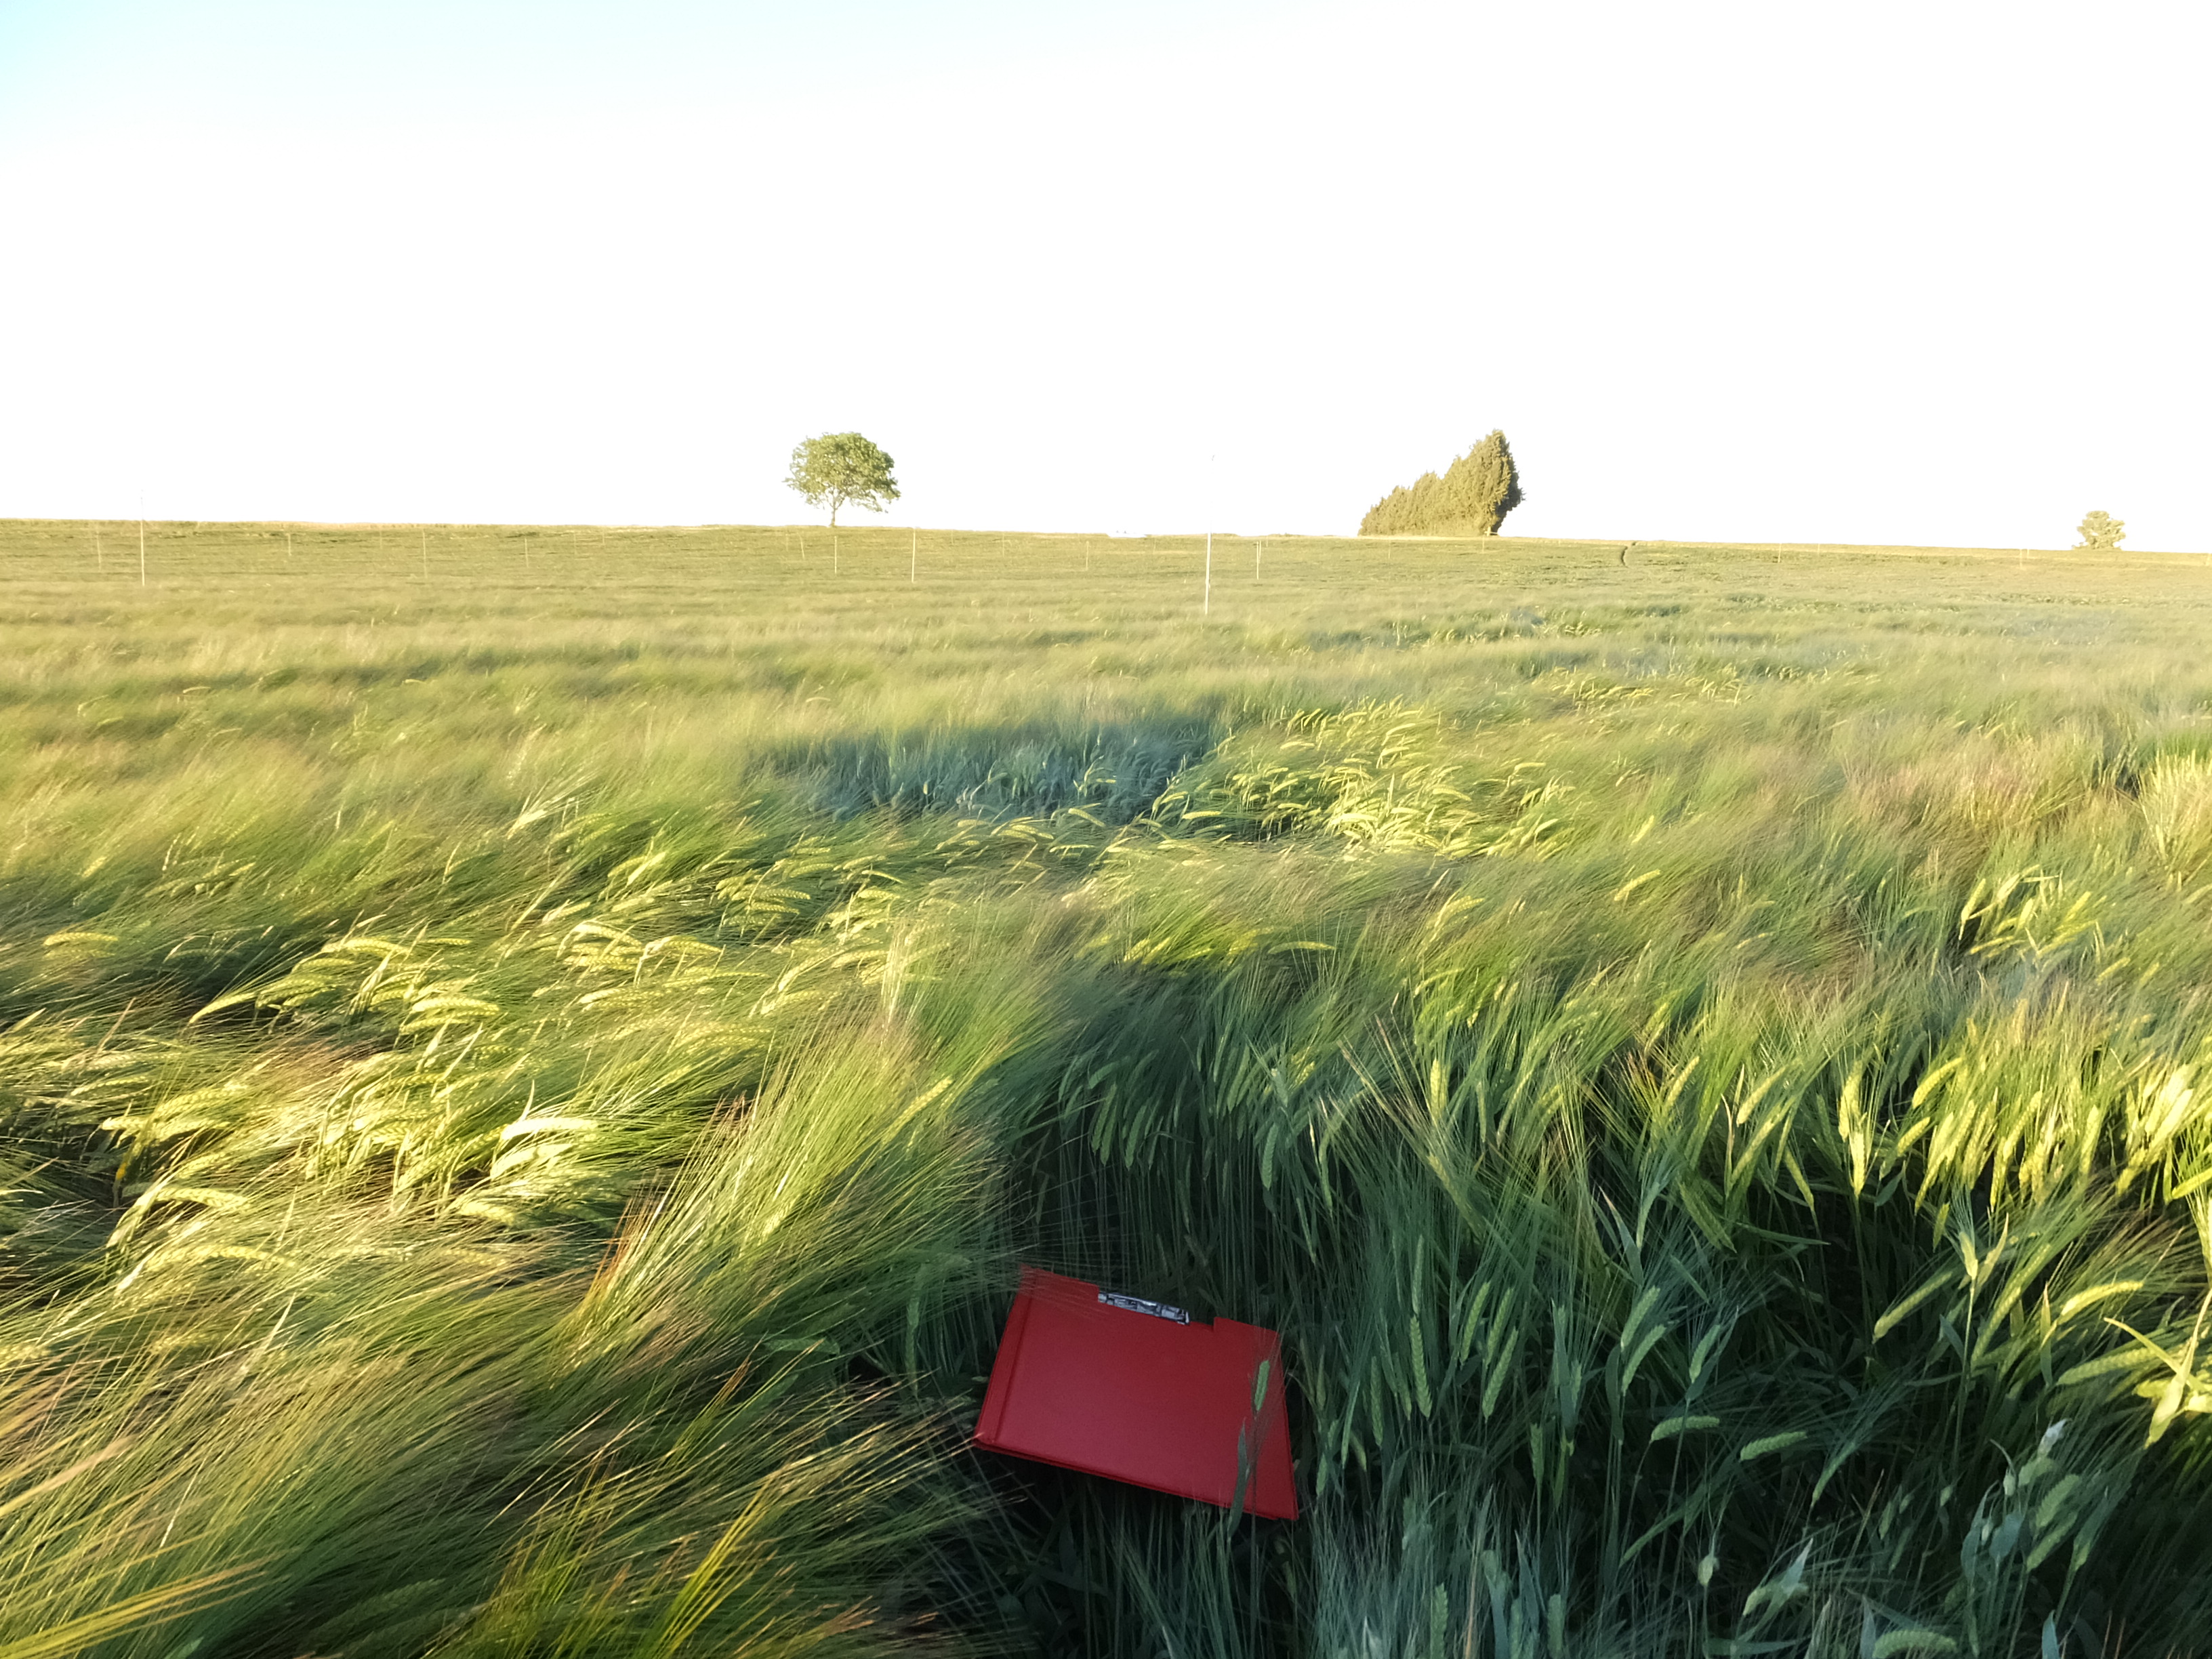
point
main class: Cropland
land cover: Barley
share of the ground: > 75 %
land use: Agriculture (excluding fallow land and kitchen gardens)
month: May
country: ES
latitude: 41.7447
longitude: -0.1303
